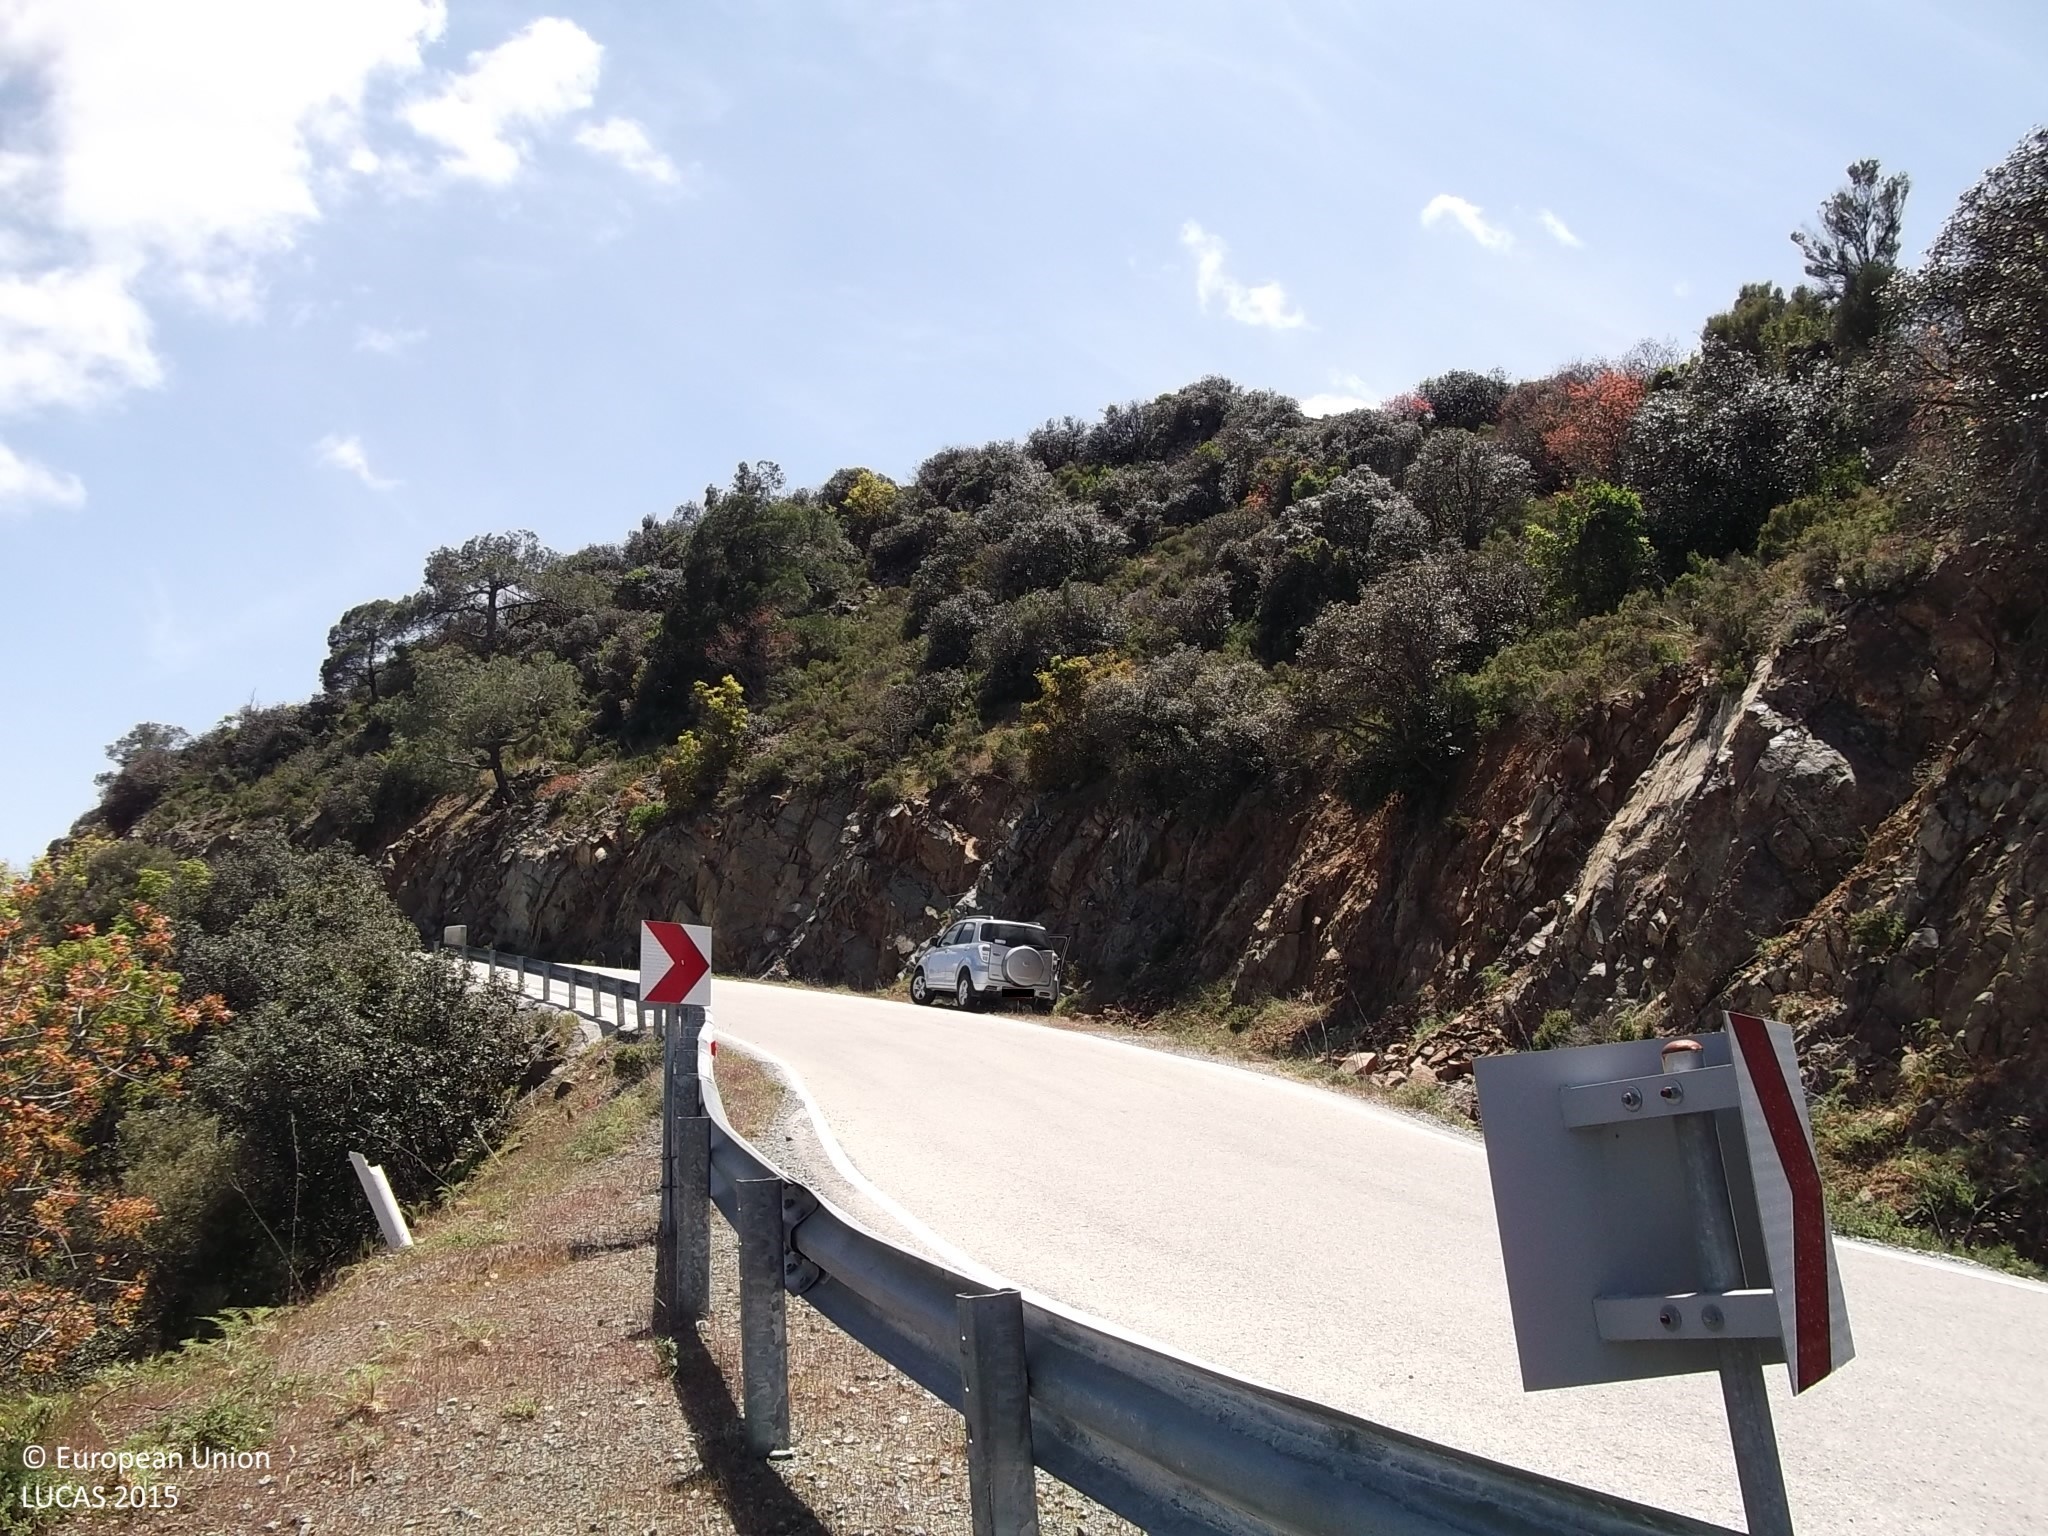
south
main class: Woodland
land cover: Pine dominated mixed woodland
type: coniferous forest of the mediterranean region
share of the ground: > 75 %
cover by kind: coniferous forest trees 60 %, broadleaved forest trees 20 %, unconsolidated bare surface 20 %
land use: Semi-natural and natural areas not in use
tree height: > 5 m
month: April
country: CY
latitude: 34.9297
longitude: 33.2019
